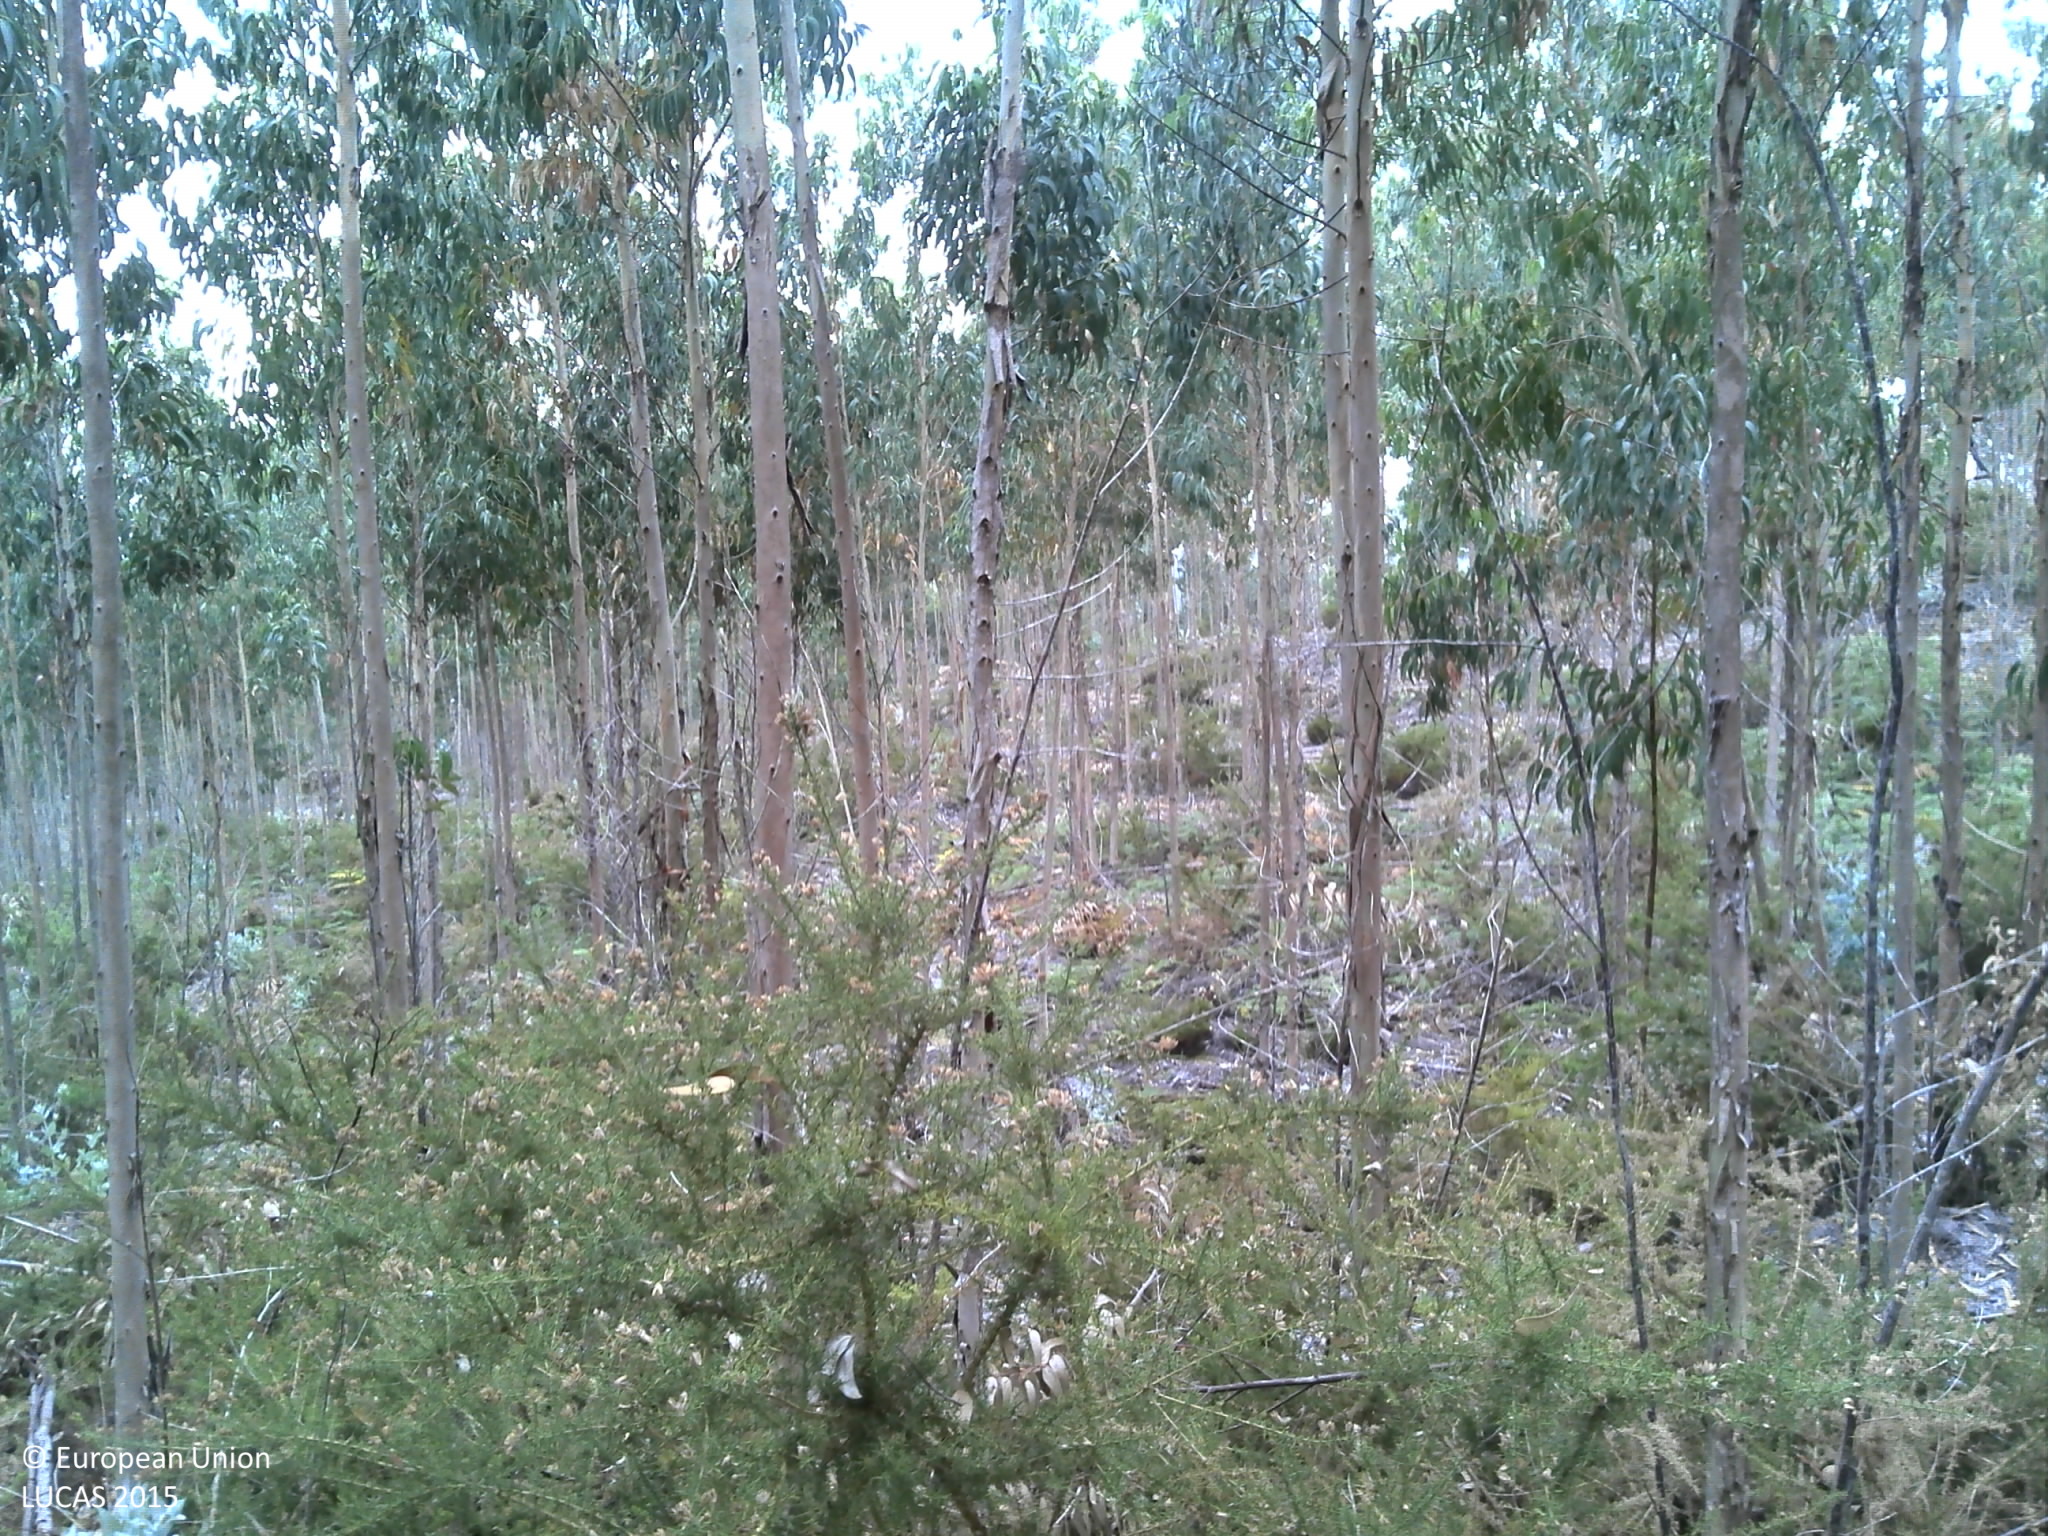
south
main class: Woodland
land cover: Broadleaved woodland
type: exotic forest
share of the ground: 50 - 75 %
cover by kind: broadleaved forest trees 60 %, unconsolidated bare surface 25 %, shrubs 15 %
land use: Forestry
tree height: > 5 m
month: June
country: PT
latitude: 39.3991
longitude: -9.2404
